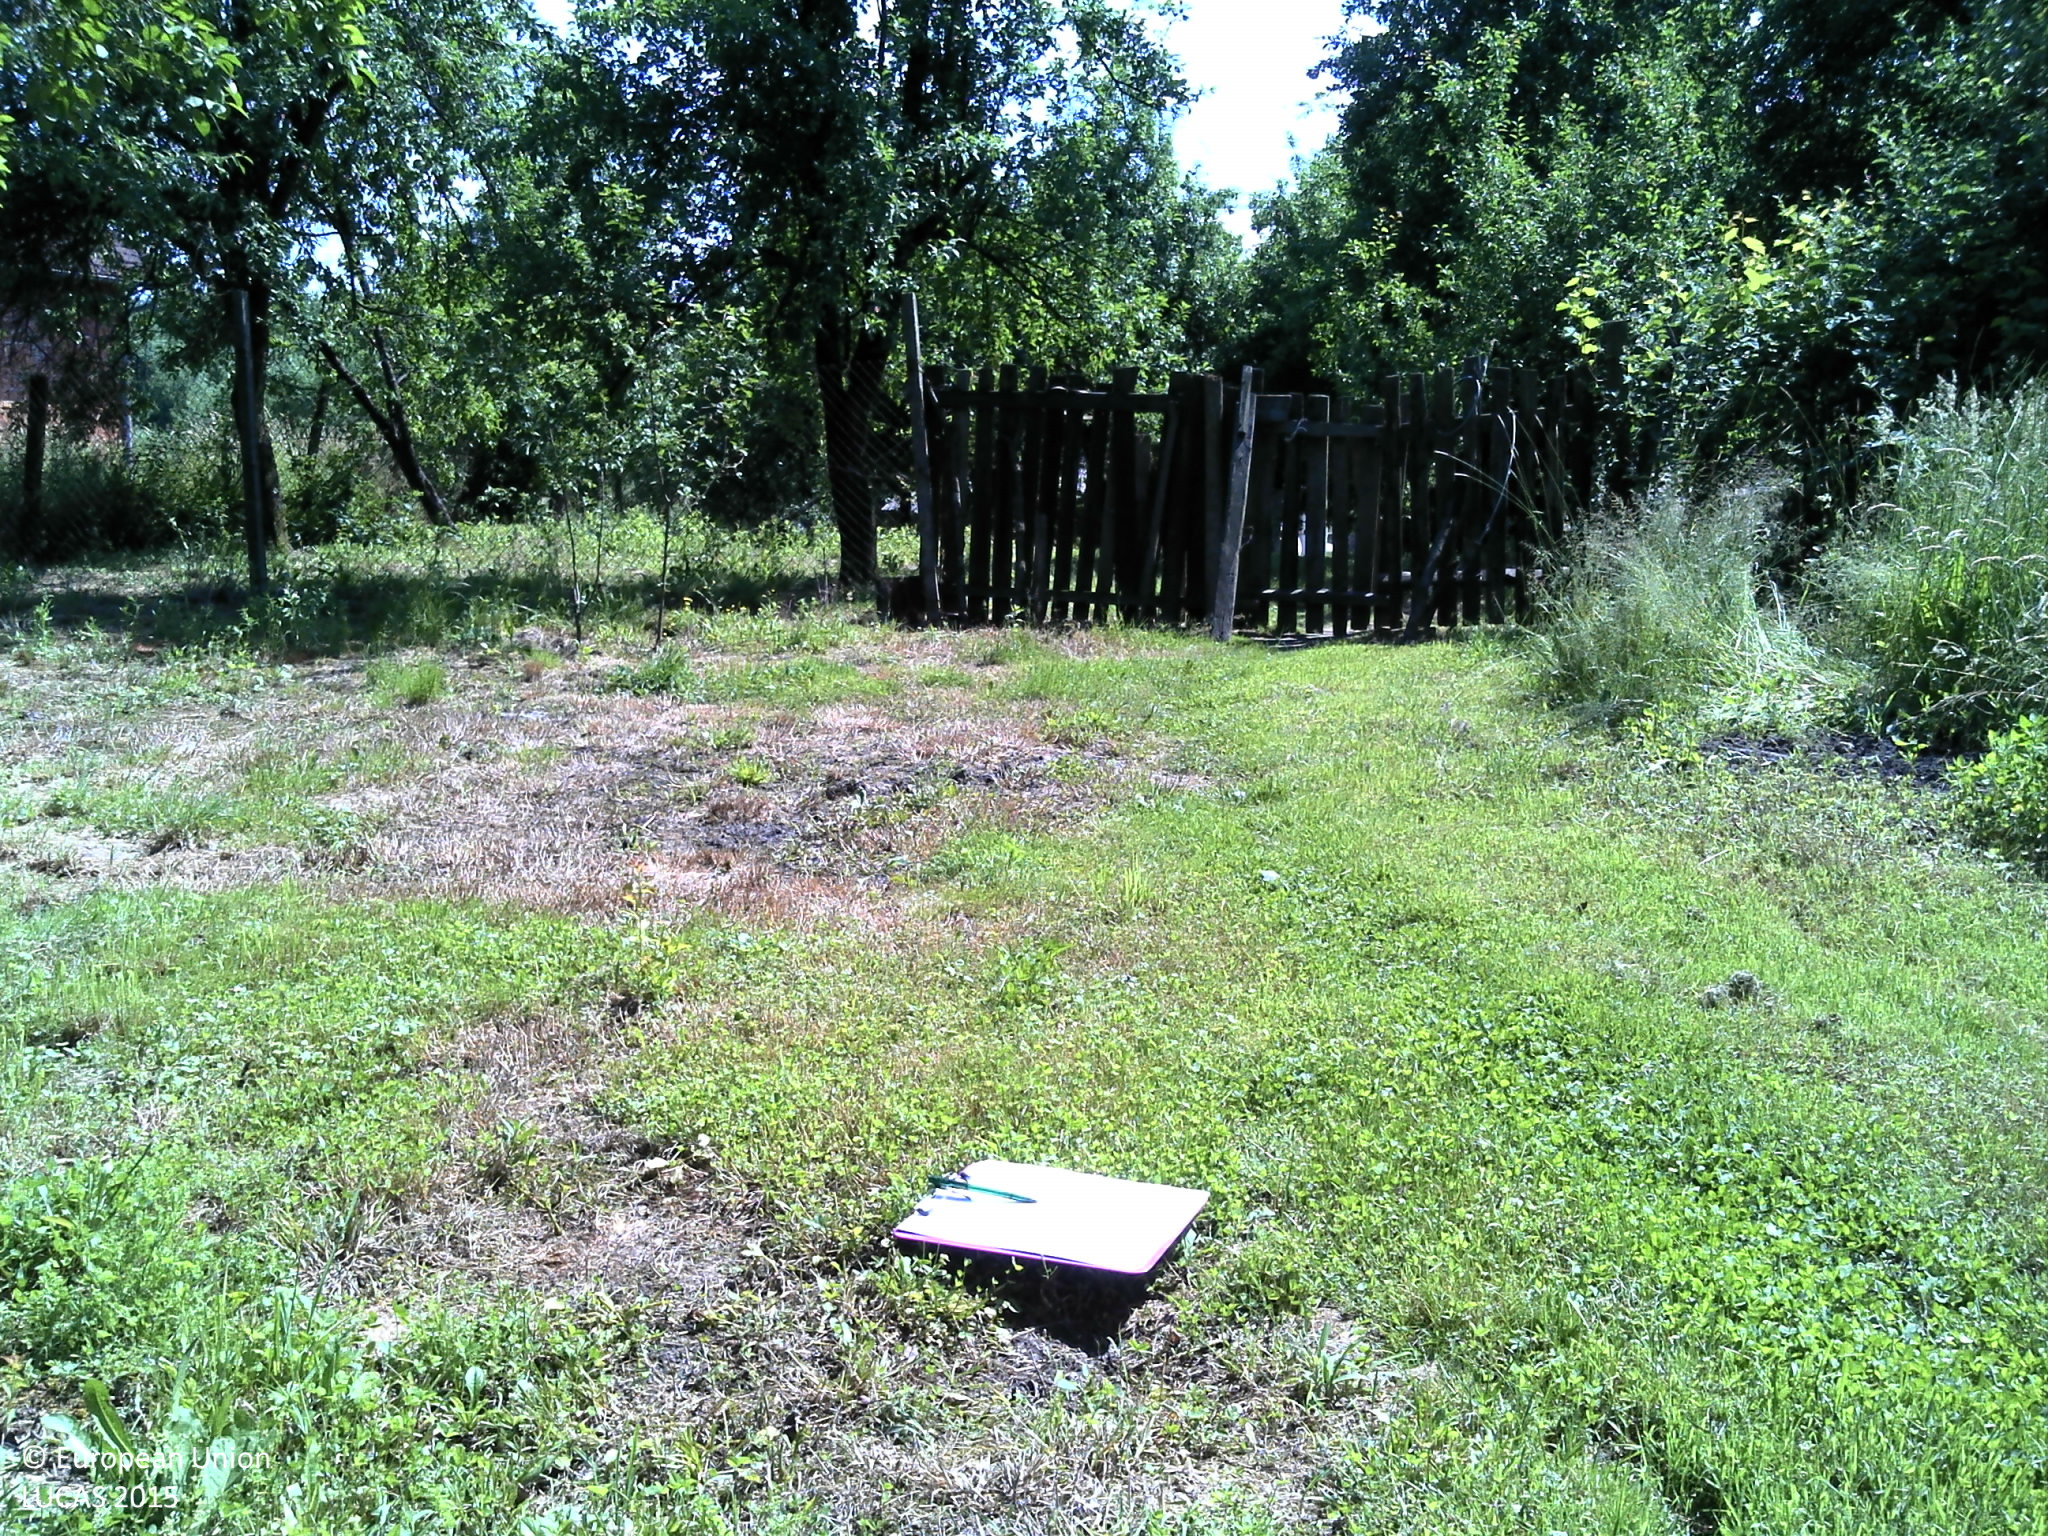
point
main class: Grassland
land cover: Spontaneously vegetated surfaces
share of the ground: > 75 %
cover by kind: herbaceous plants 100 %
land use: Fallow land
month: May
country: HR
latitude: 45.6128
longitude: 17.8127
